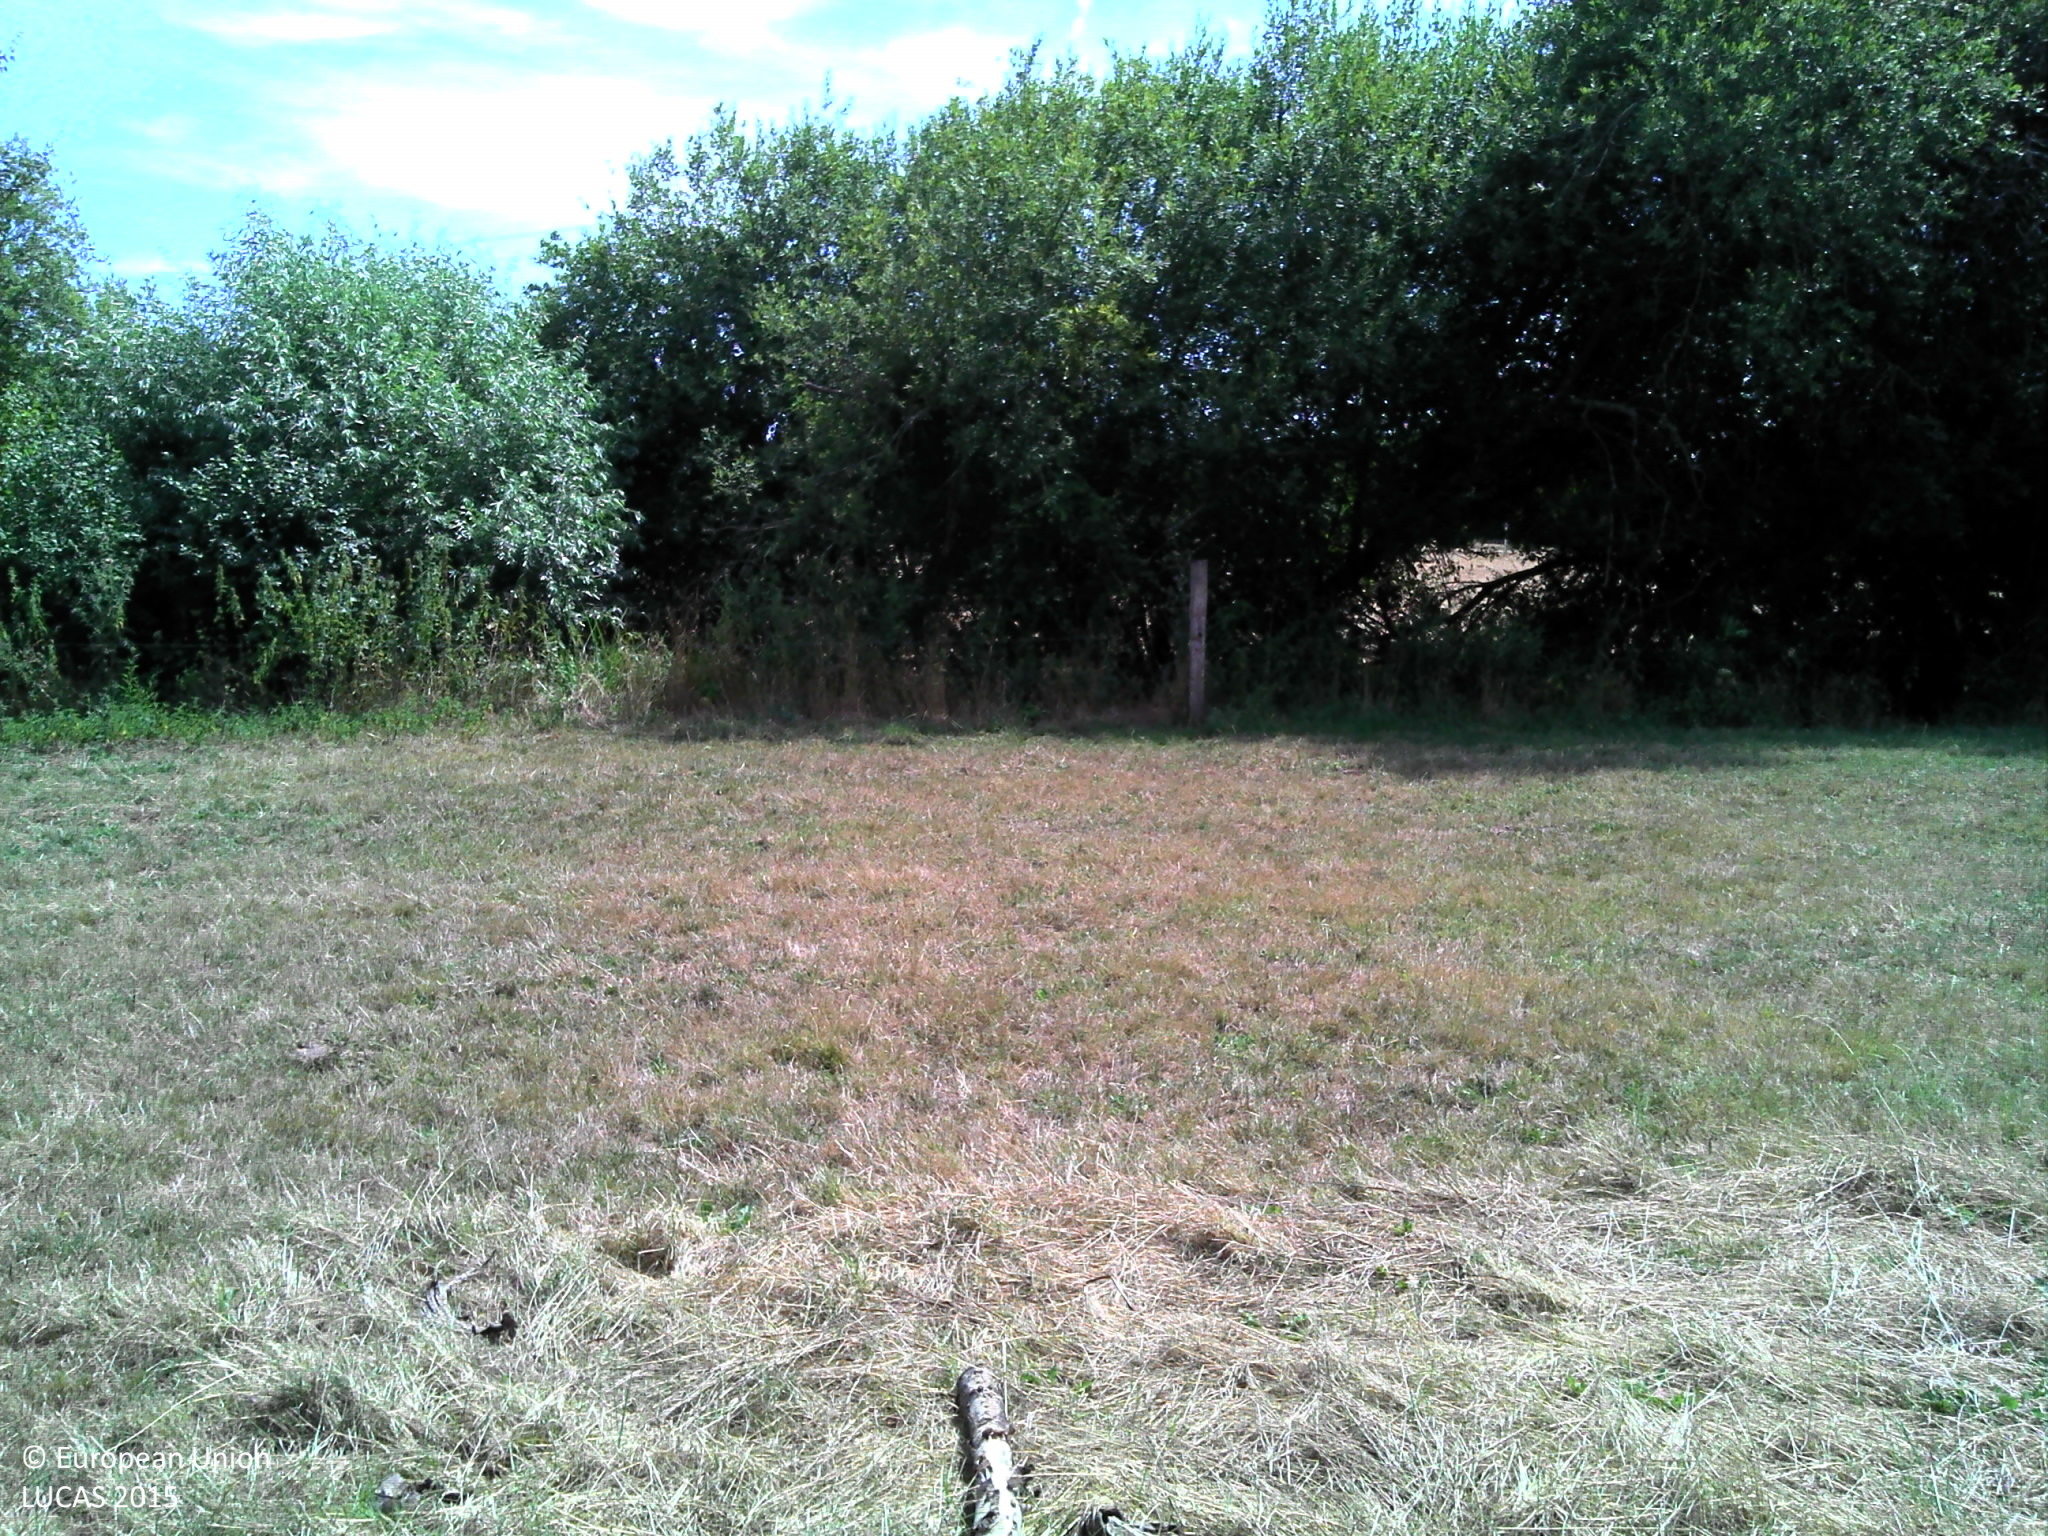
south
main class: Grassland
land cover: Grassland without tree/shrub cover
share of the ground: > 75 %
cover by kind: herbaceous plants 100 %
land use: Agriculture (excluding fallow land and kitchen gardens)
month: August
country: FR
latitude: 47.7705
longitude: 3.0684
